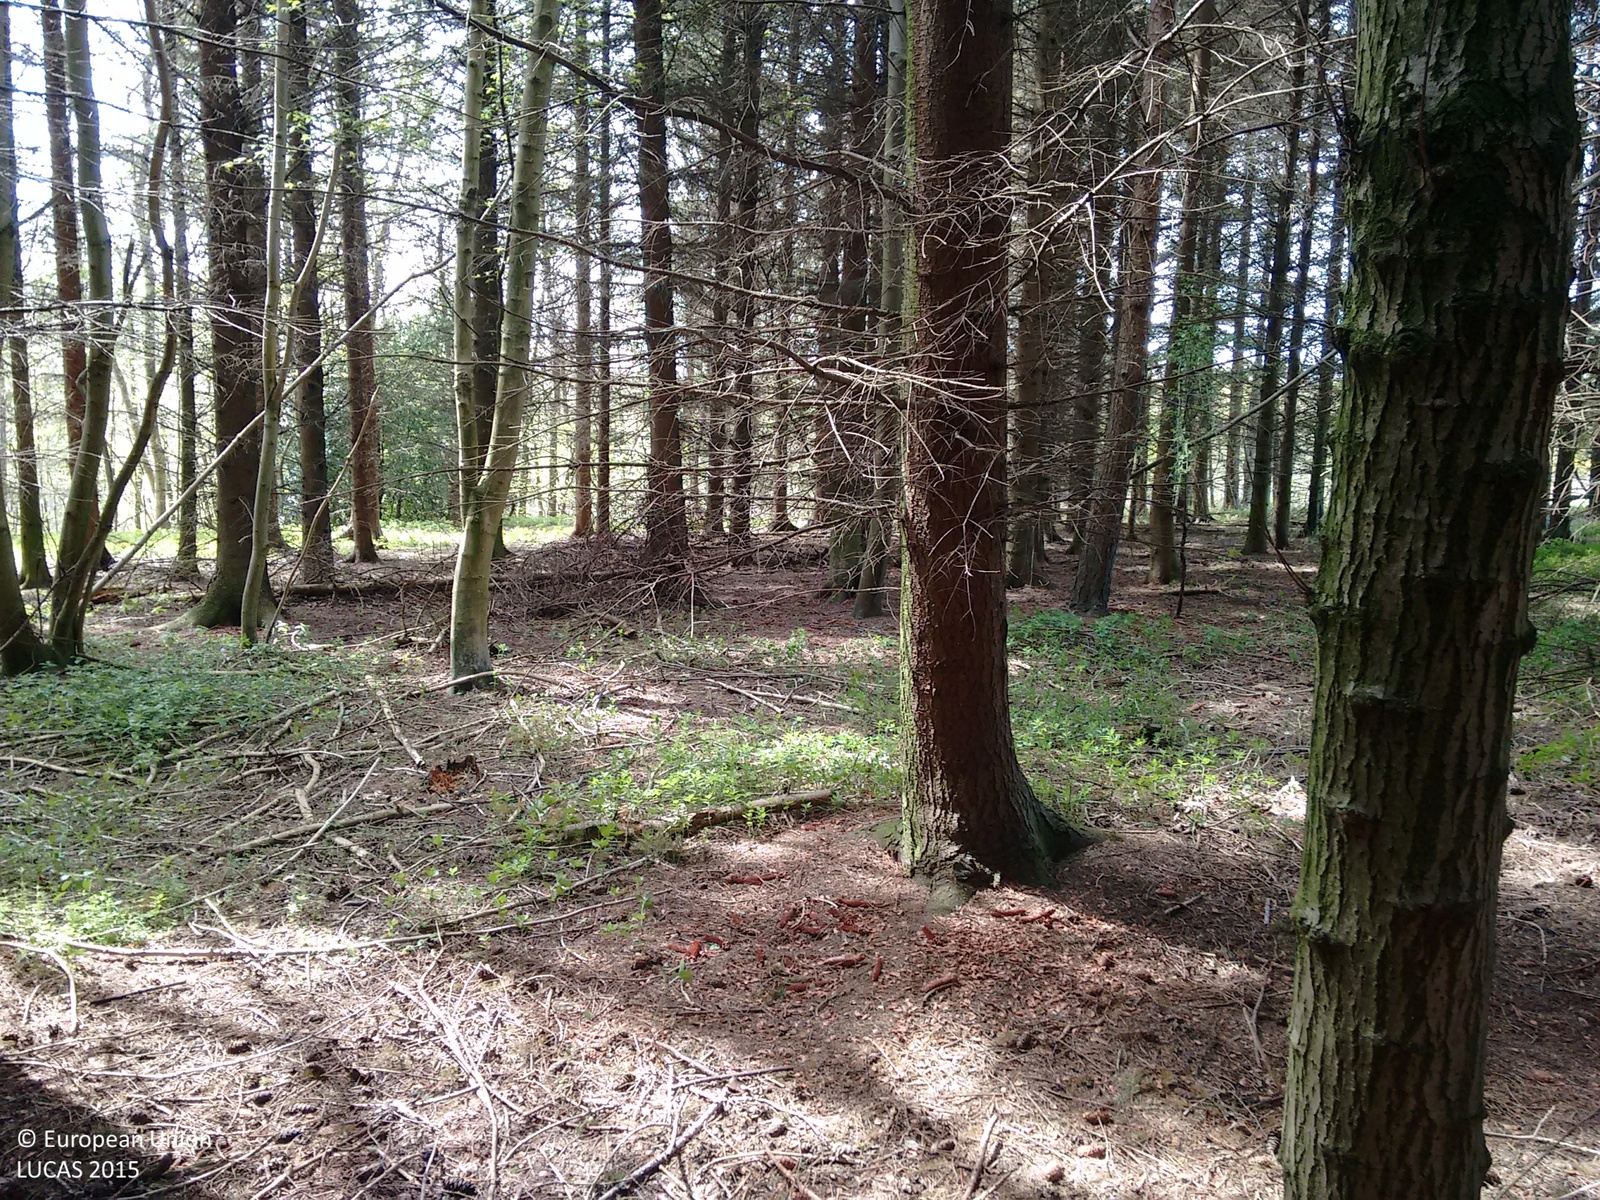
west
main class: Woodland
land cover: Pine dominated coniferous woodland
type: exotic forest
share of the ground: > 75 %
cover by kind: coniferous forest trees 100 %
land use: Forestry
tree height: > 5 m
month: May
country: GB
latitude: 55.3234
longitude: -1.6959
